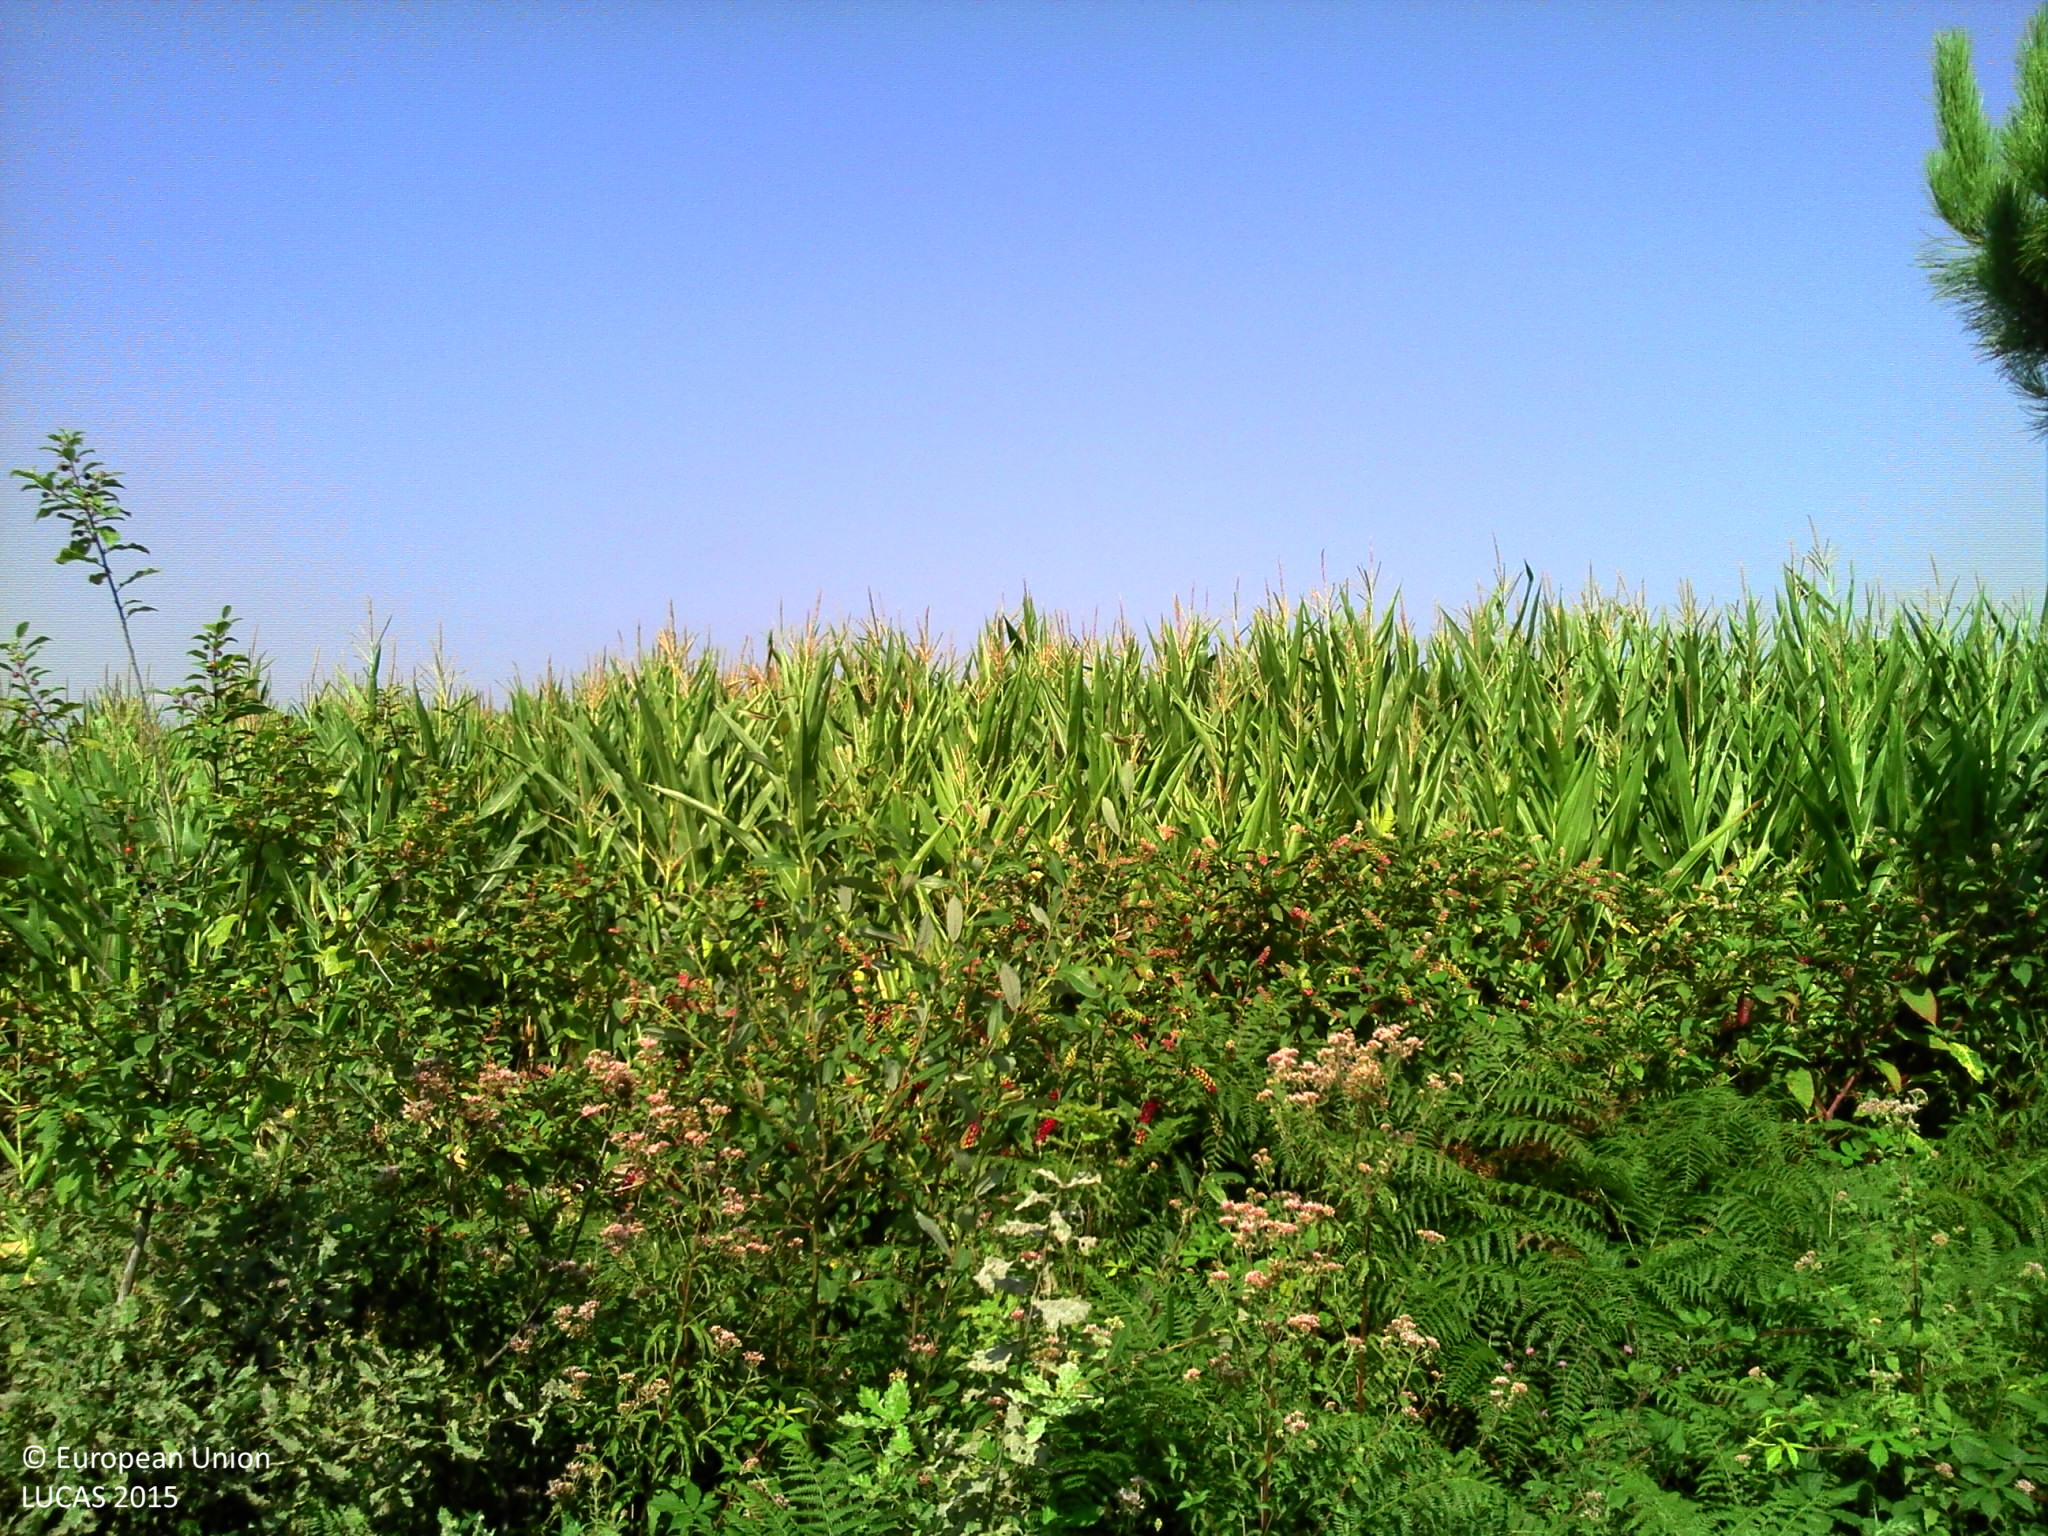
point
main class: Cropland
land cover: Maize
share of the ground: > 75 %
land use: Agriculture (excluding fallow land and kitchen gardens)
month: August
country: FR
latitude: 43.7918
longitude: -0.5627
